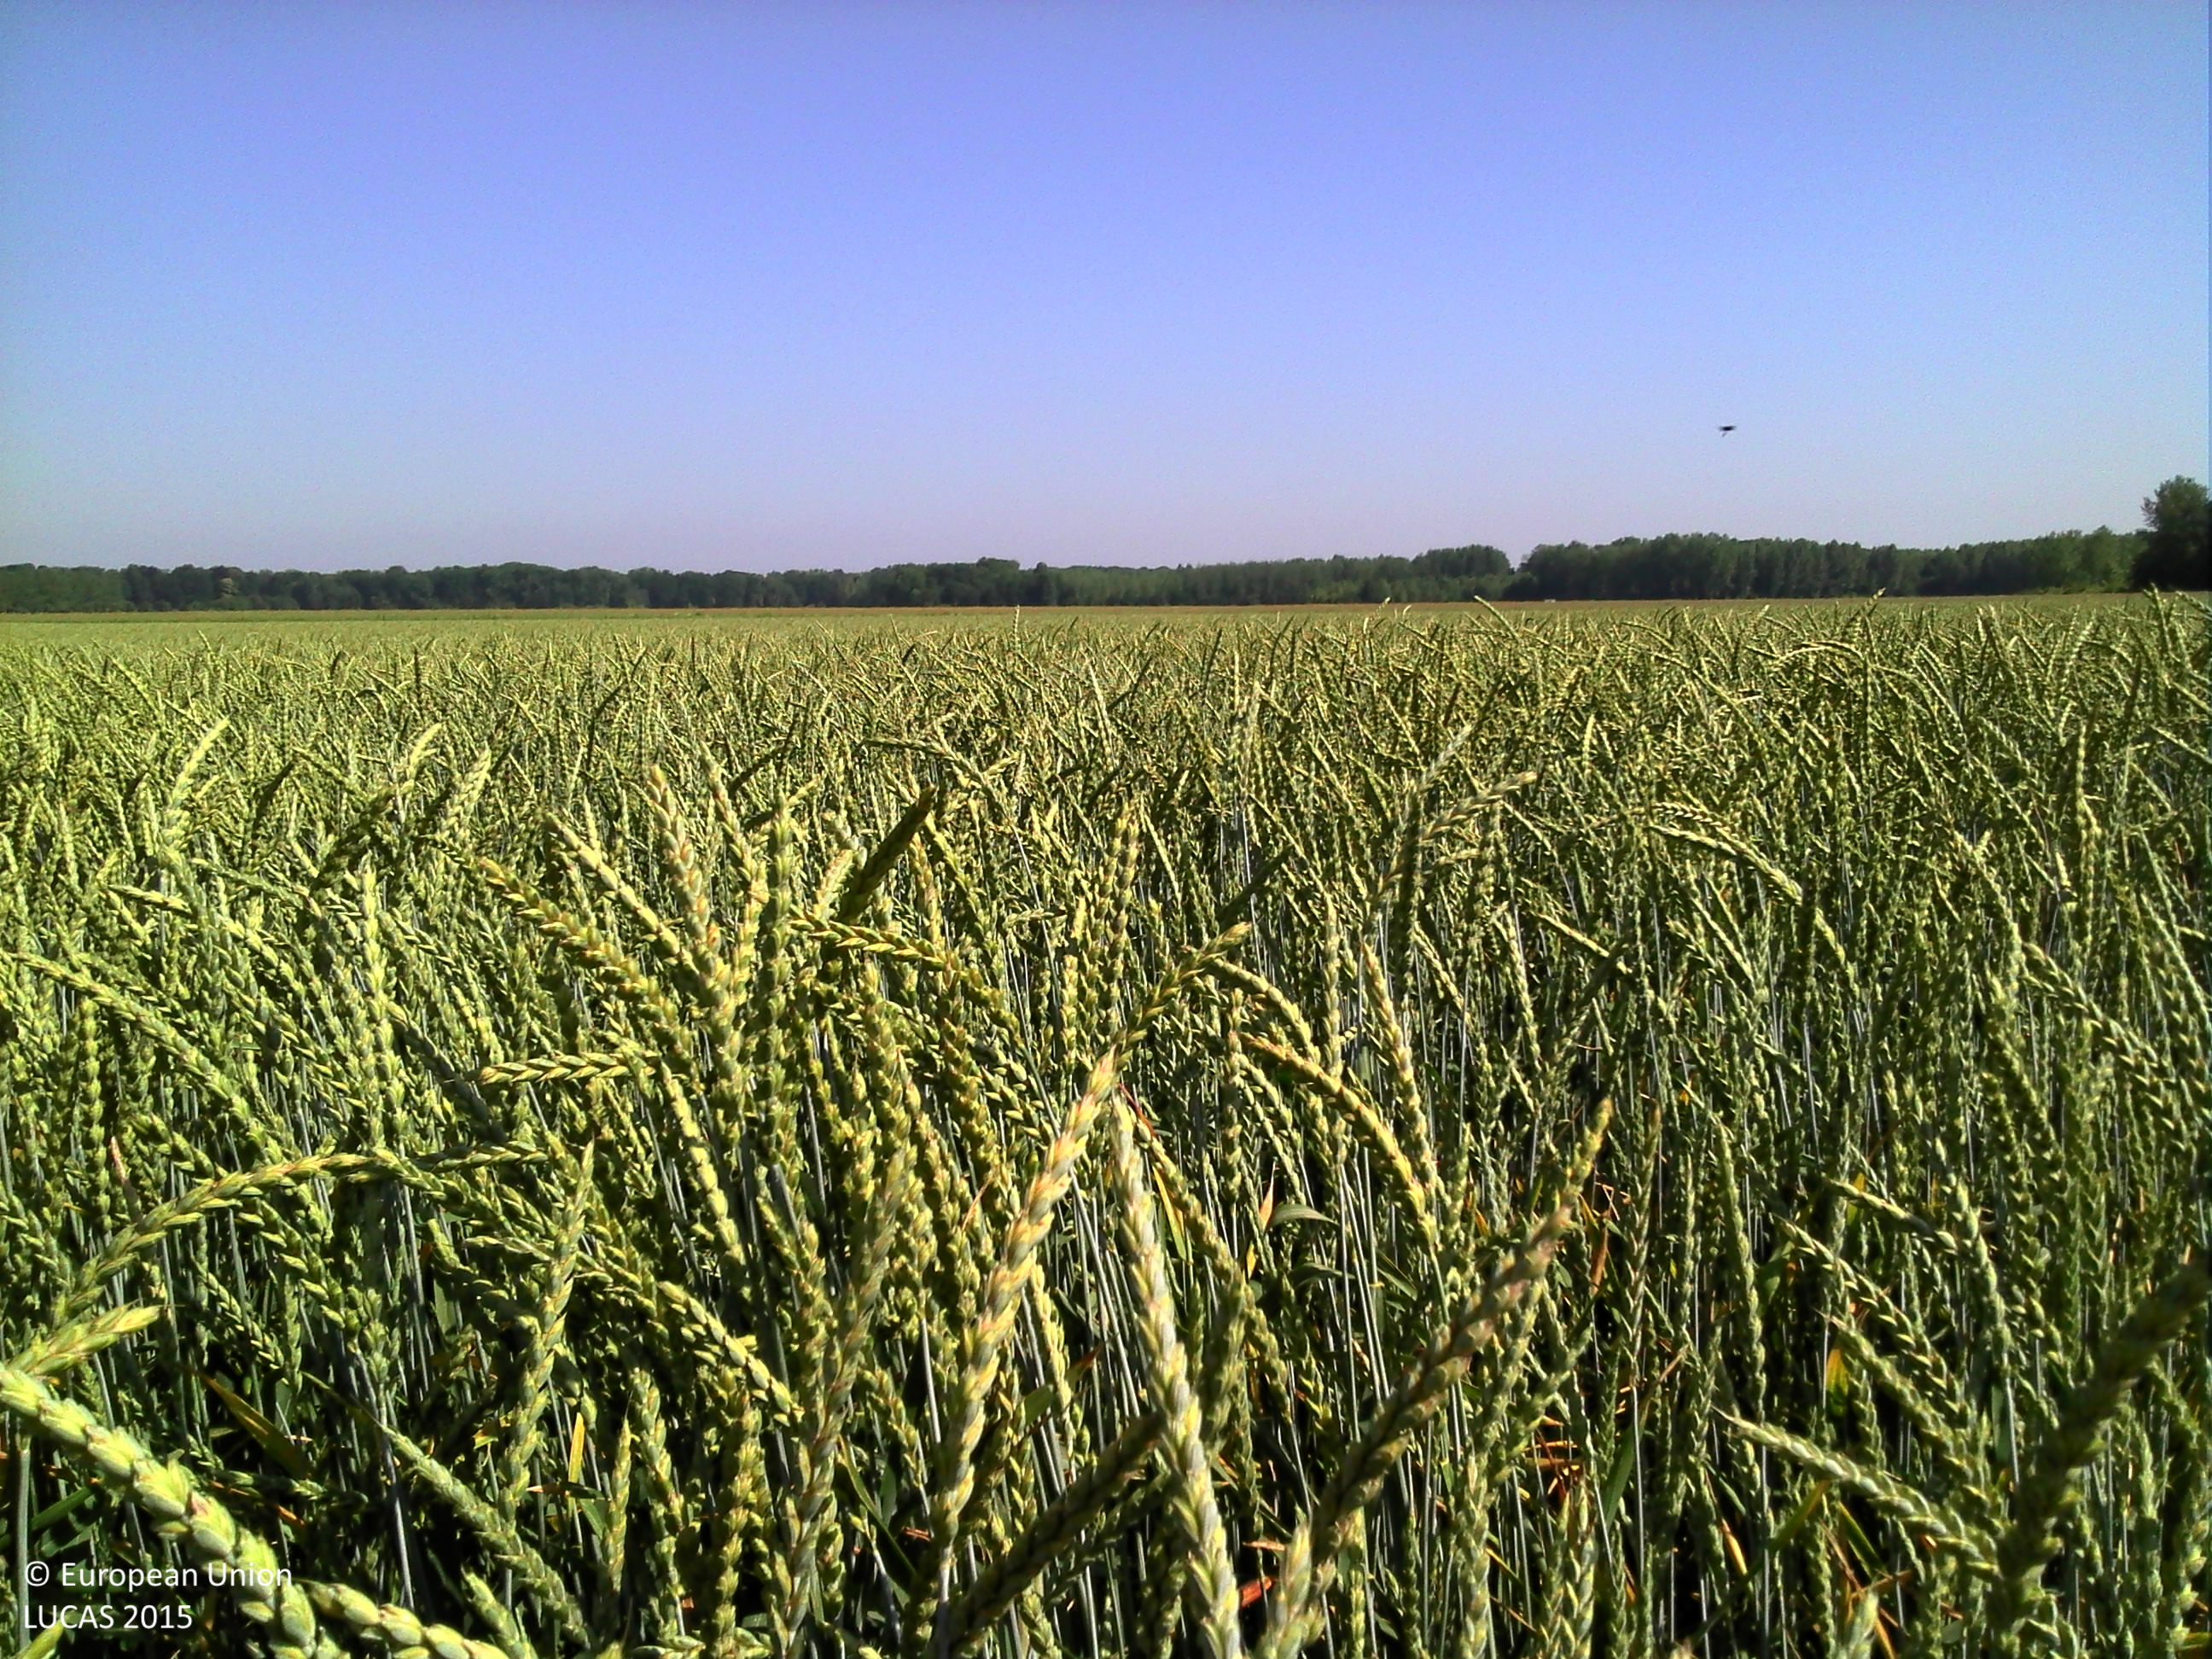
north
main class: Cropland
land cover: Common wheat
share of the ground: > 75 %
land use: Agriculture (excluding fallow land and kitchen gardens)
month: June
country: BE
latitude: 50.8199
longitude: 5.1571
